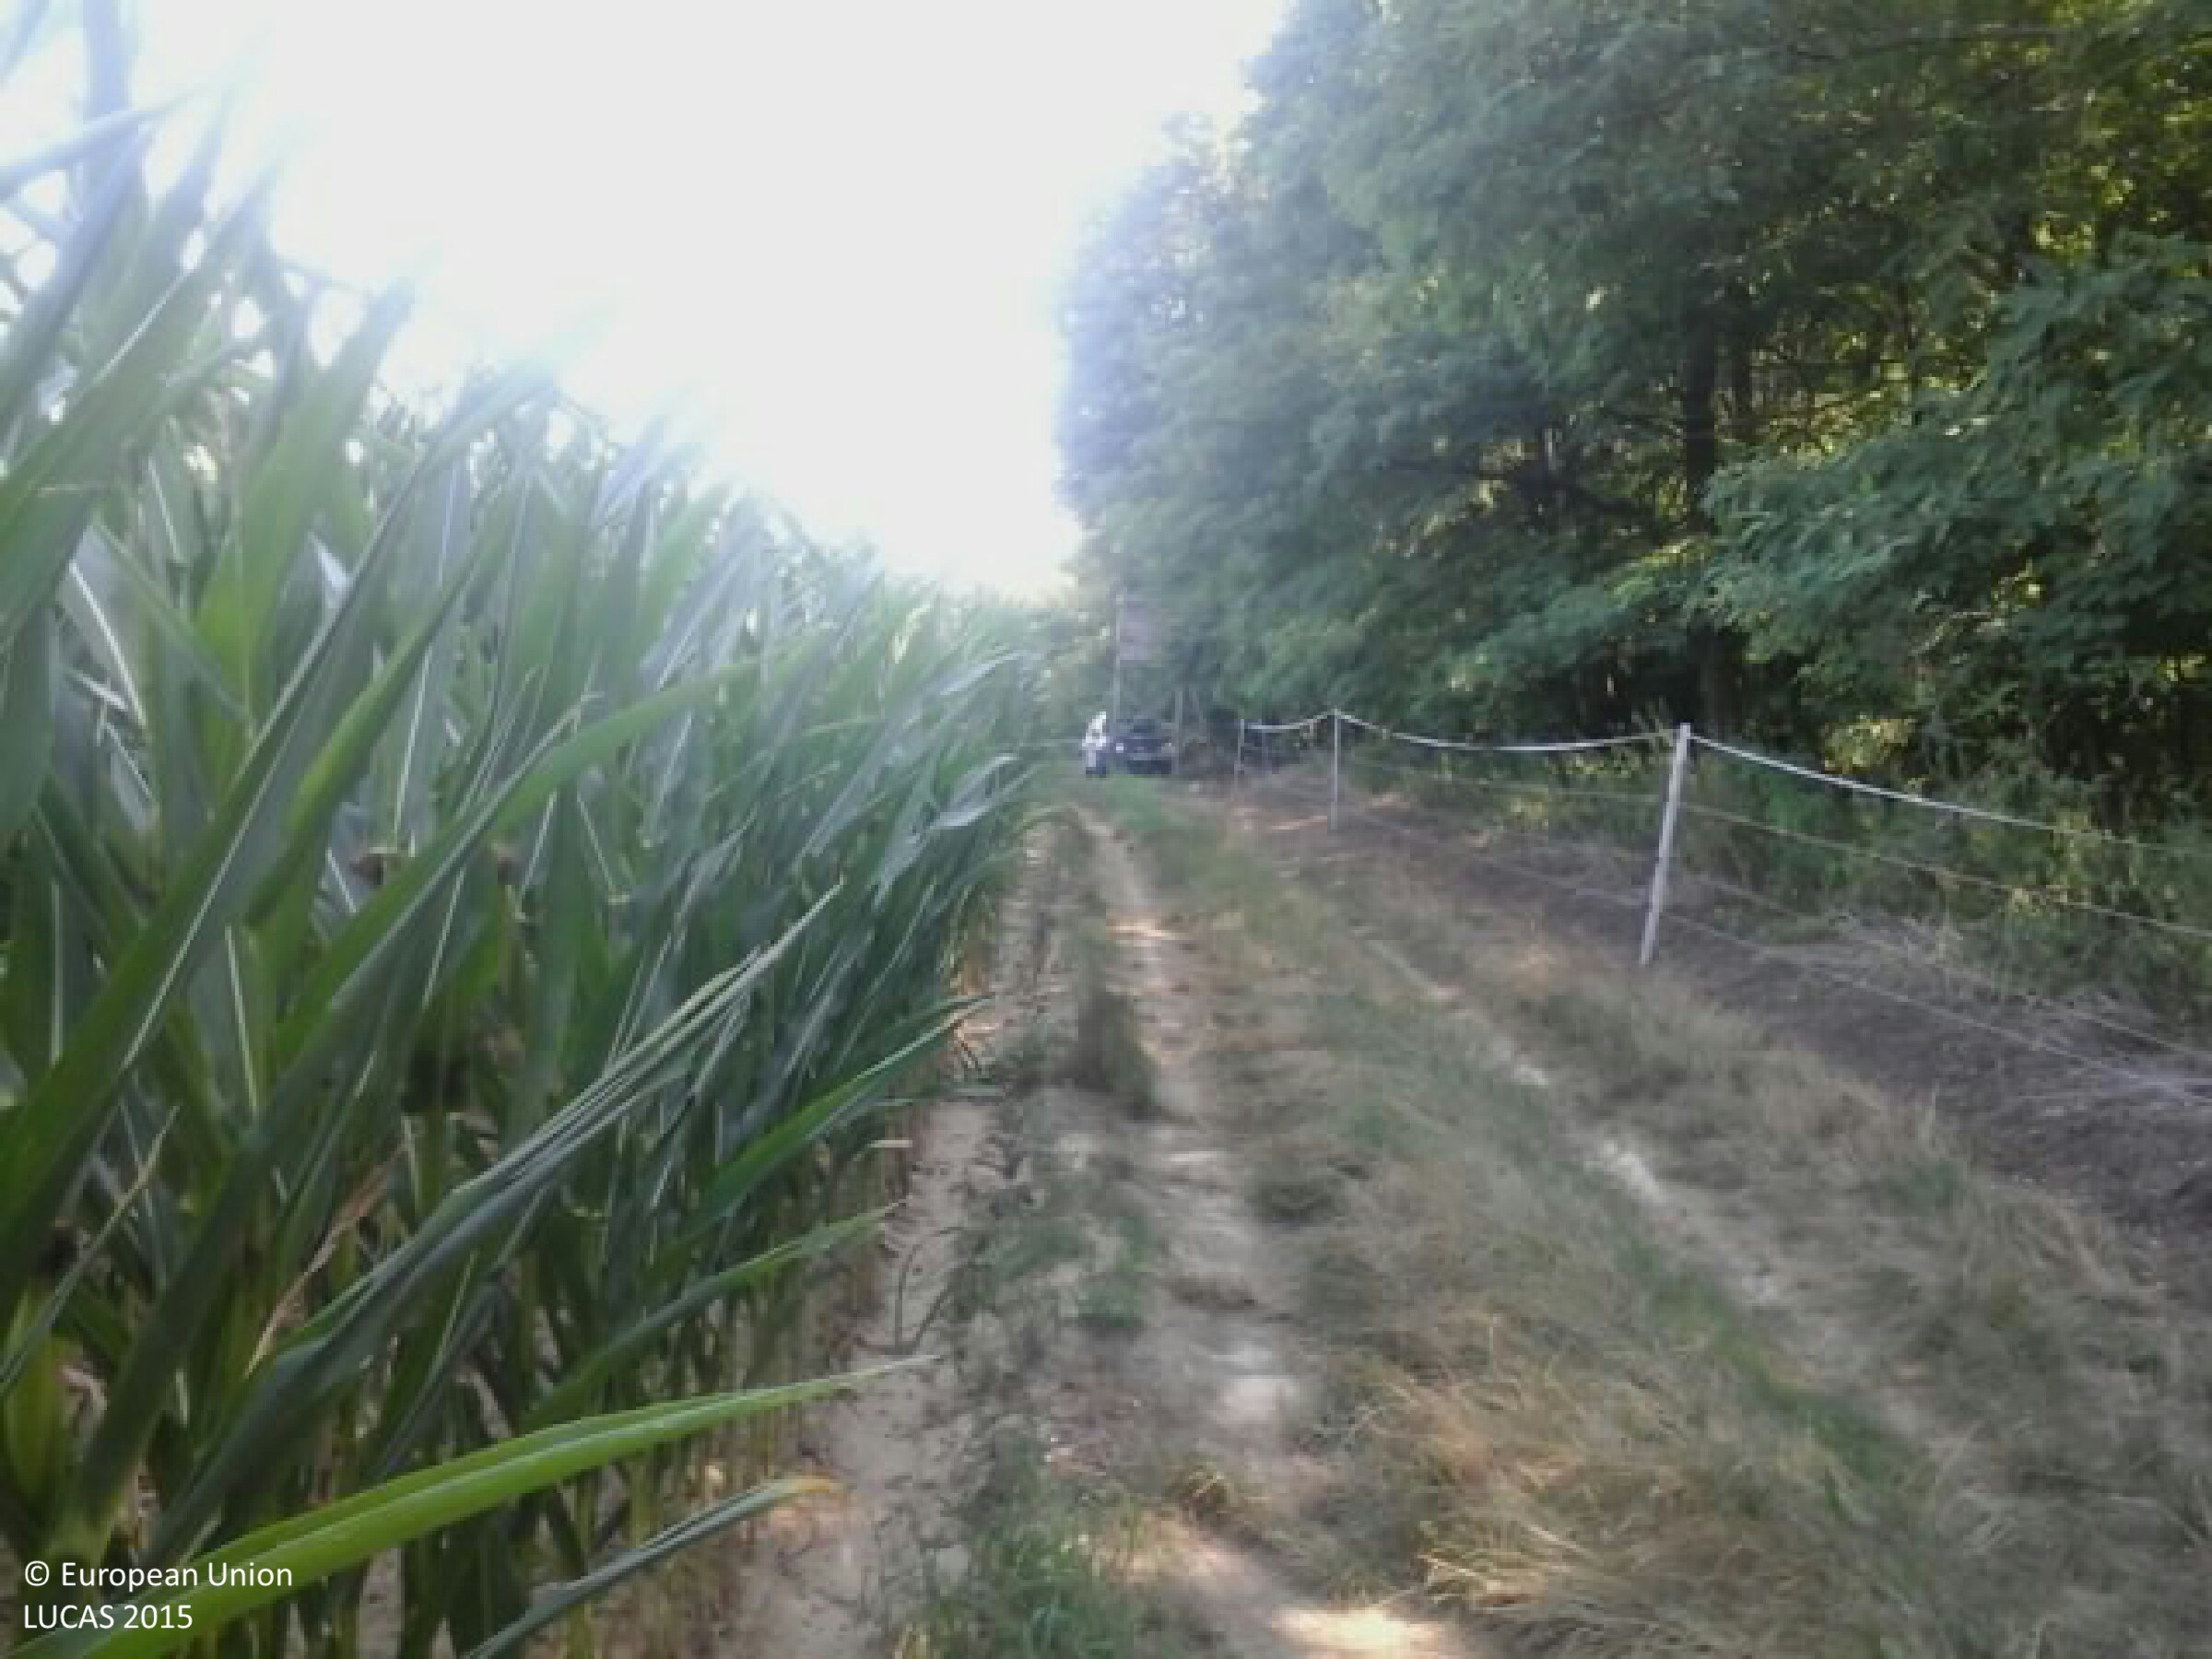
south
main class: Cropland
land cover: Maize
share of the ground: > 75 %
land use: Agriculture (excluding fallow land and kitchen gardens)
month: July
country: HU
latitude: 46.2223
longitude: 17.1199
